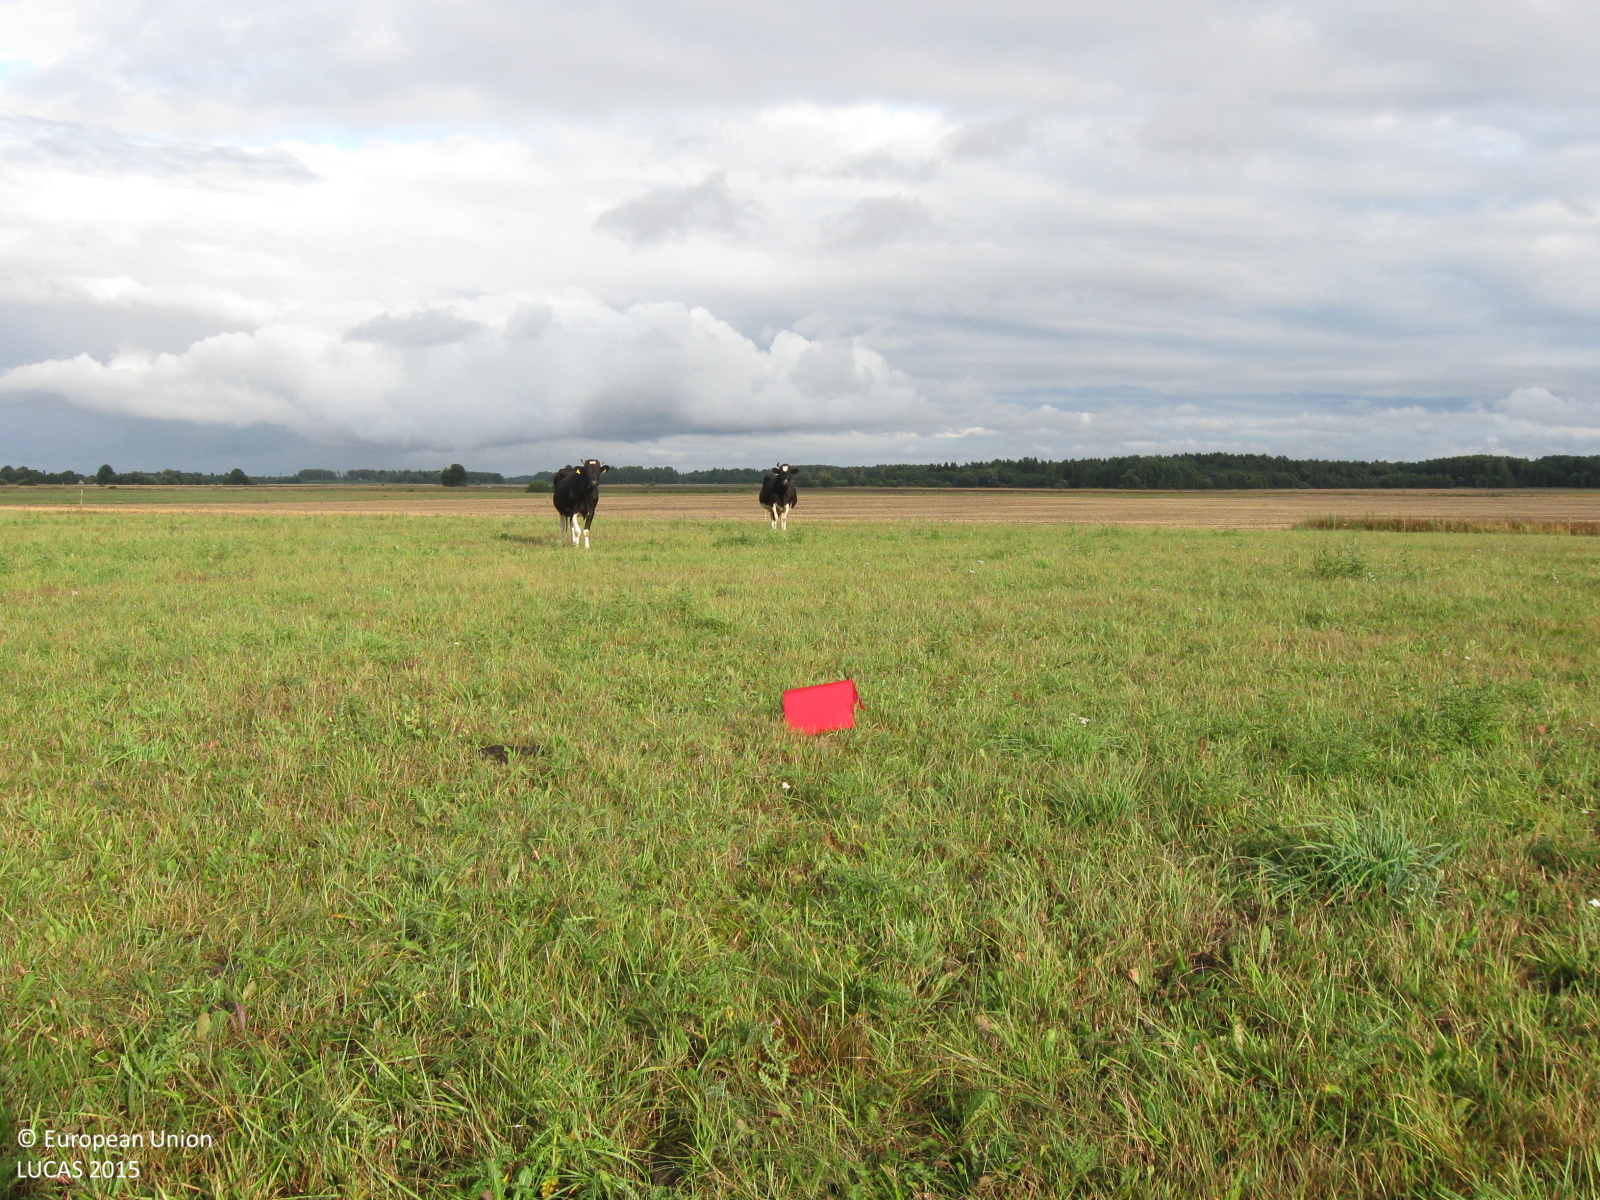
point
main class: Grassland
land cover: Grassland without tree/shrub cover
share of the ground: > 75 %
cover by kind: herbaceous plants 100 %
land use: Agriculture (excluding fallow land and kitchen gardens)
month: August
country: LT
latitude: 55.2599
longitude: 23.2451
